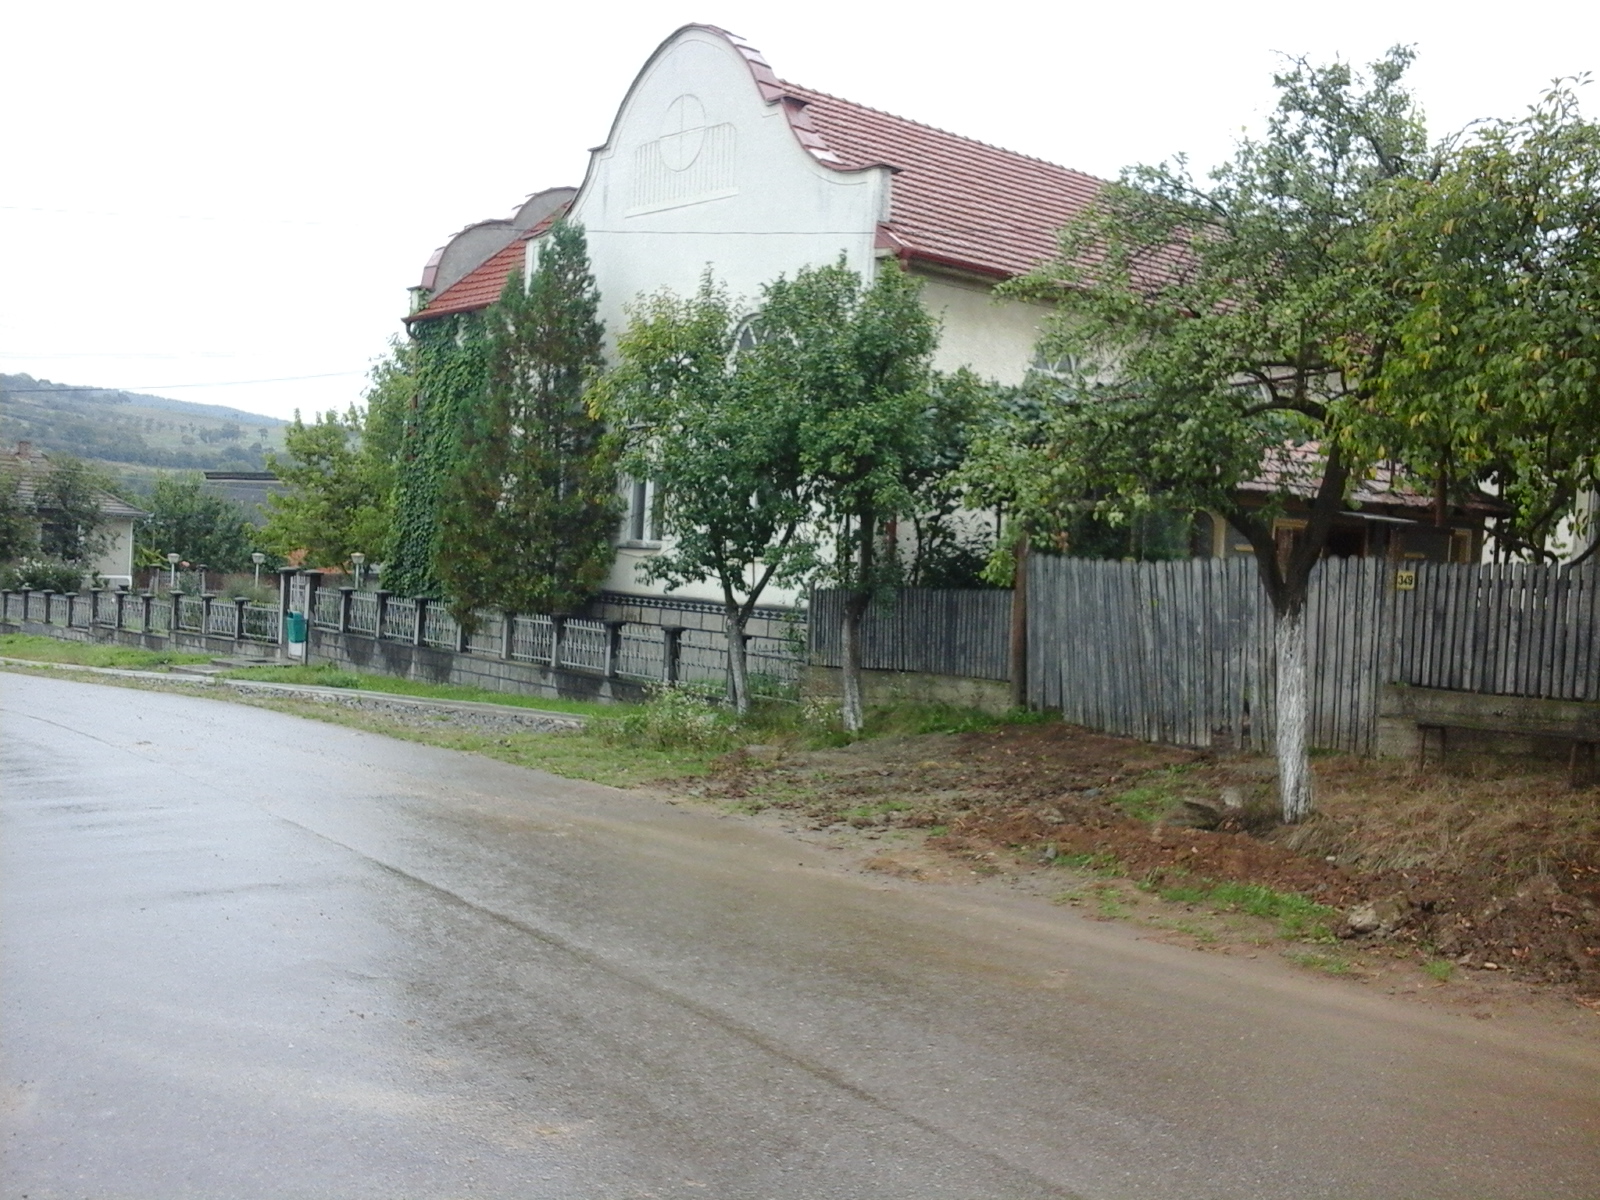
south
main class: Cropland
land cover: Maize
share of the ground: > 75 %
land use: Agriculture (excluding fallow land and kitchen gardens)
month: September
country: RO
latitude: 47.2105
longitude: 22.5596
